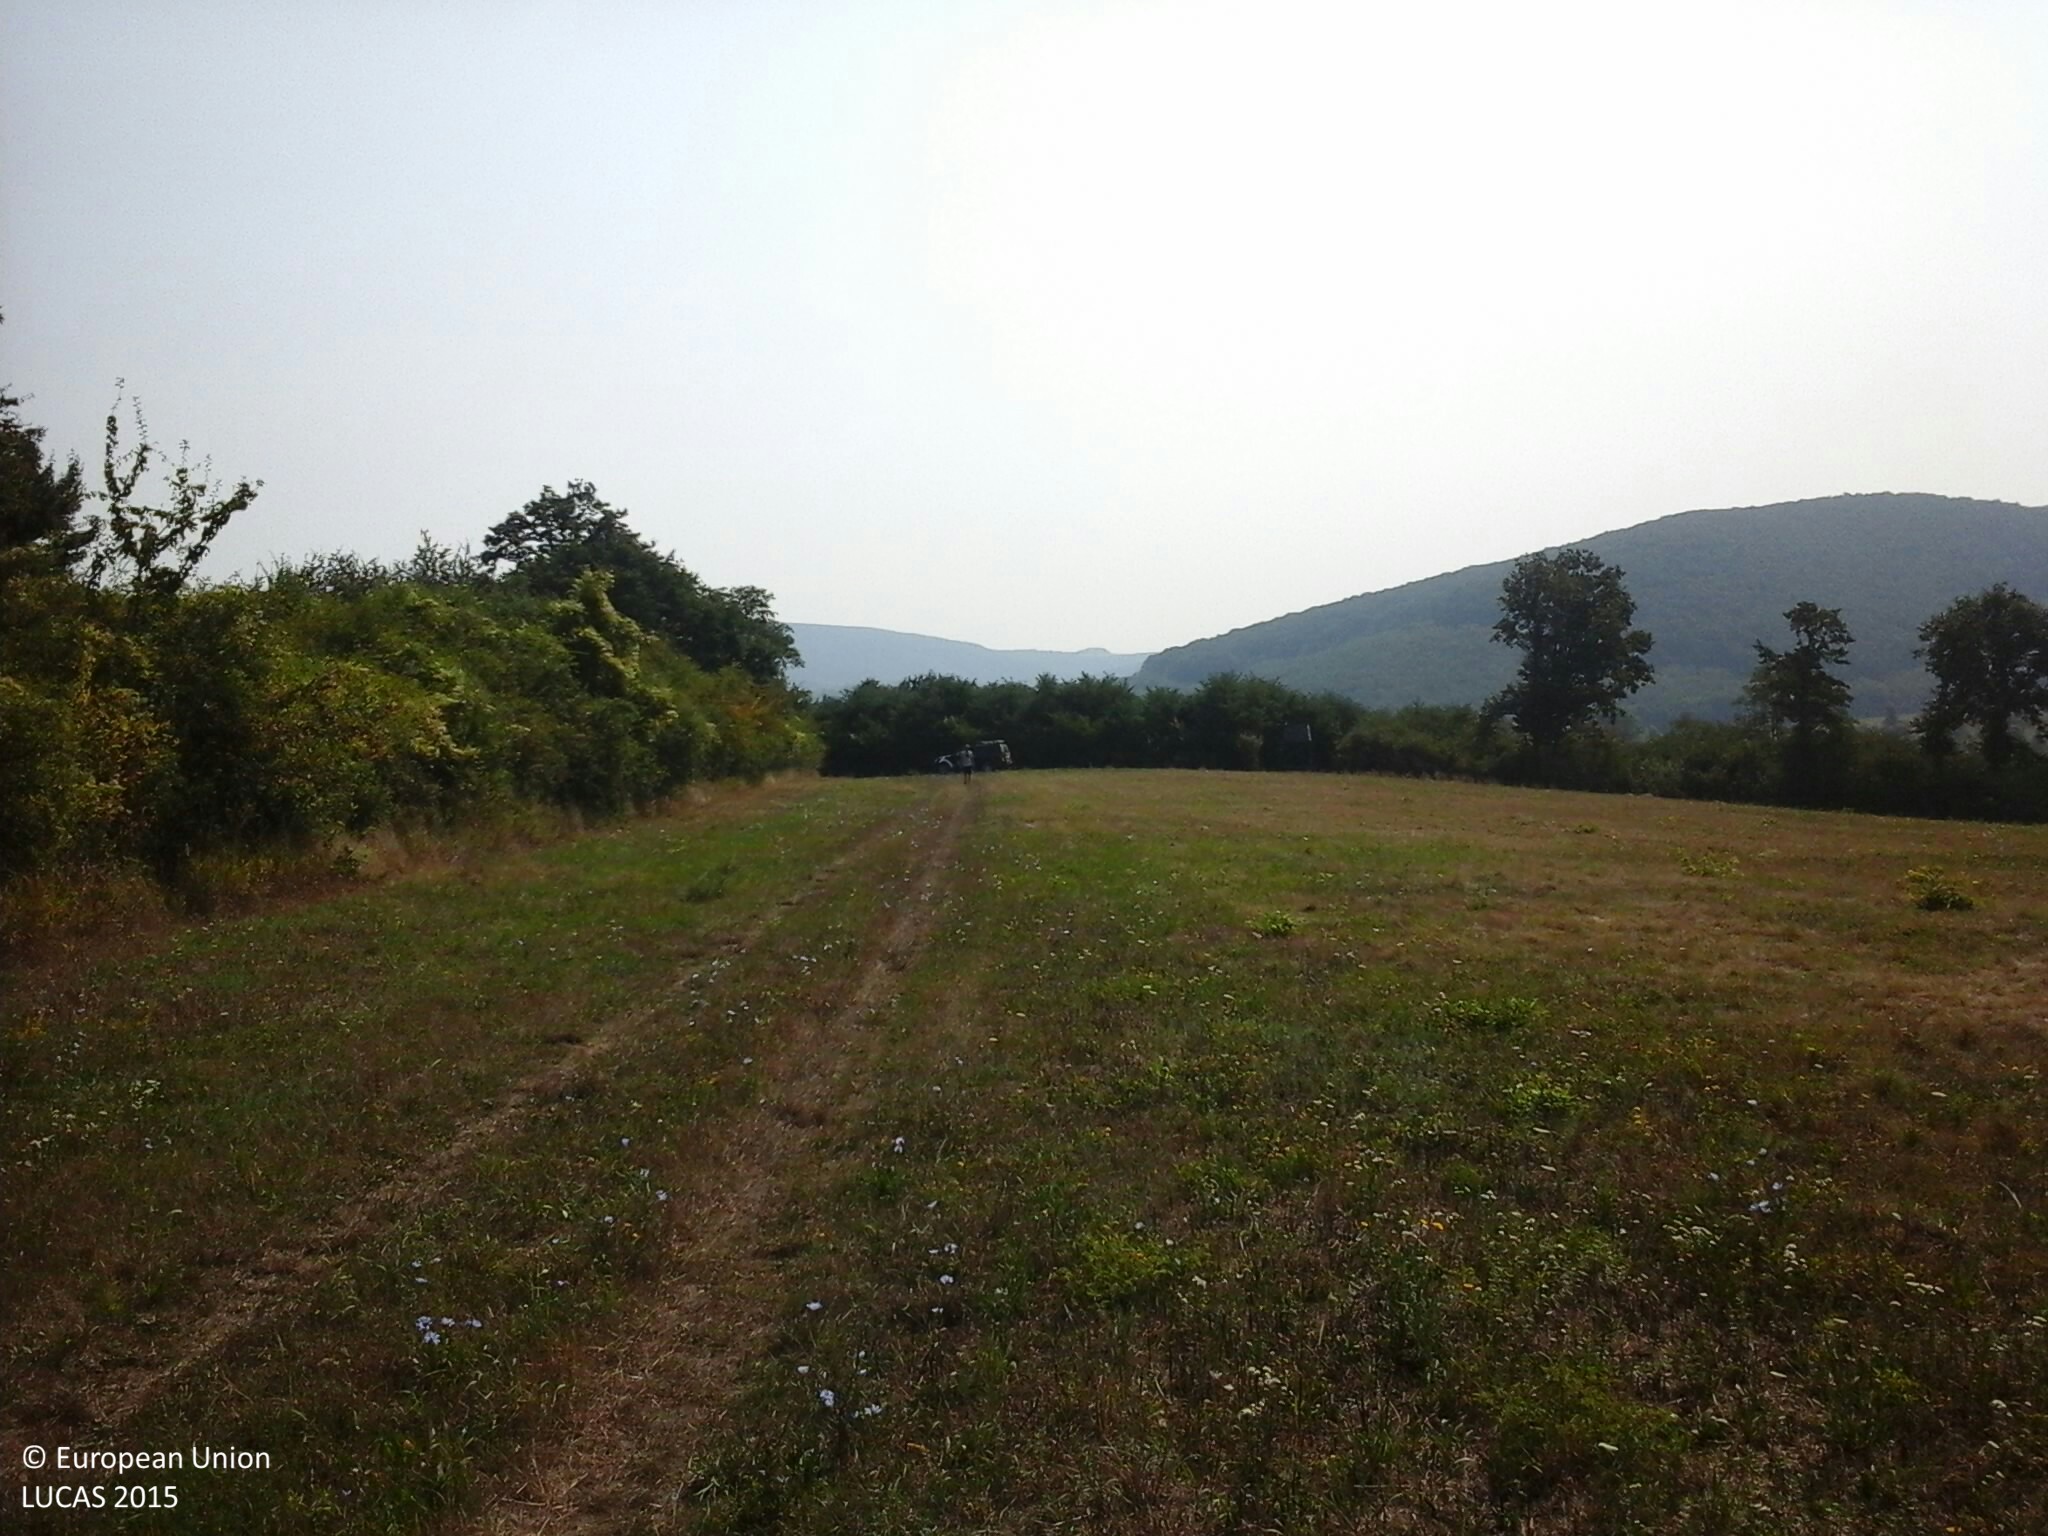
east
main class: Grassland
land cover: Grassland without tree/shrub cover
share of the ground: > 75 %
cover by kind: herbaceous plants 100 %
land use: Agriculture (excluding fallow land and kitchen gardens)
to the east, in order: Grassland without tree/shrub cover; Tracks; Grassland without tree/shrub cover; Shrubland with sparse tree cover; Broadleaved woodland; Tracks; Broadleaved woodland; Tracks; Lucerne
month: August
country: HU
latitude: 47.8739
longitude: 19.2057
